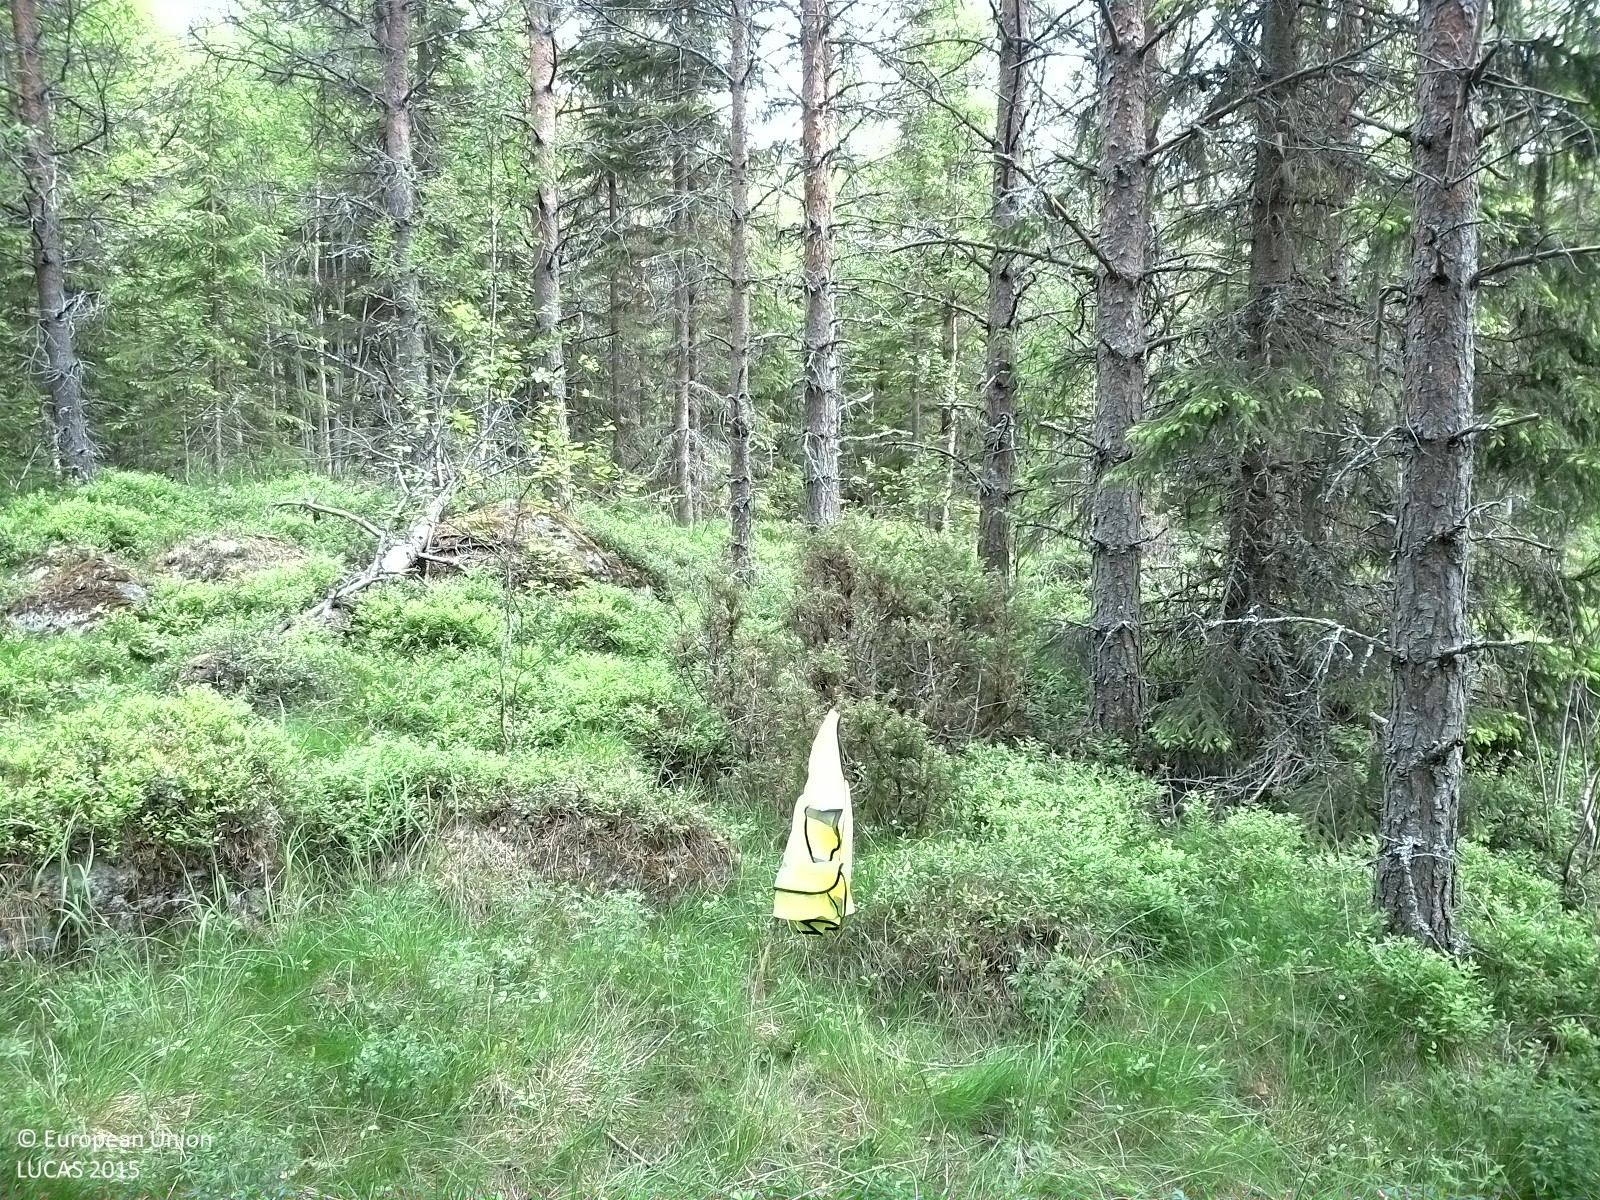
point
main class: Woodland
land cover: Pine dominated coniferous woodland
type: boreal forest
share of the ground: 25 - 50 %
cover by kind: coniferous forest trees 45 %, shrubs 30 %, herbaceous plants 20 %, broadleaved forest trees 5 %
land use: Forestry
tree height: > 5 m
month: June
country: SE
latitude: 62.0897
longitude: 16.1284
